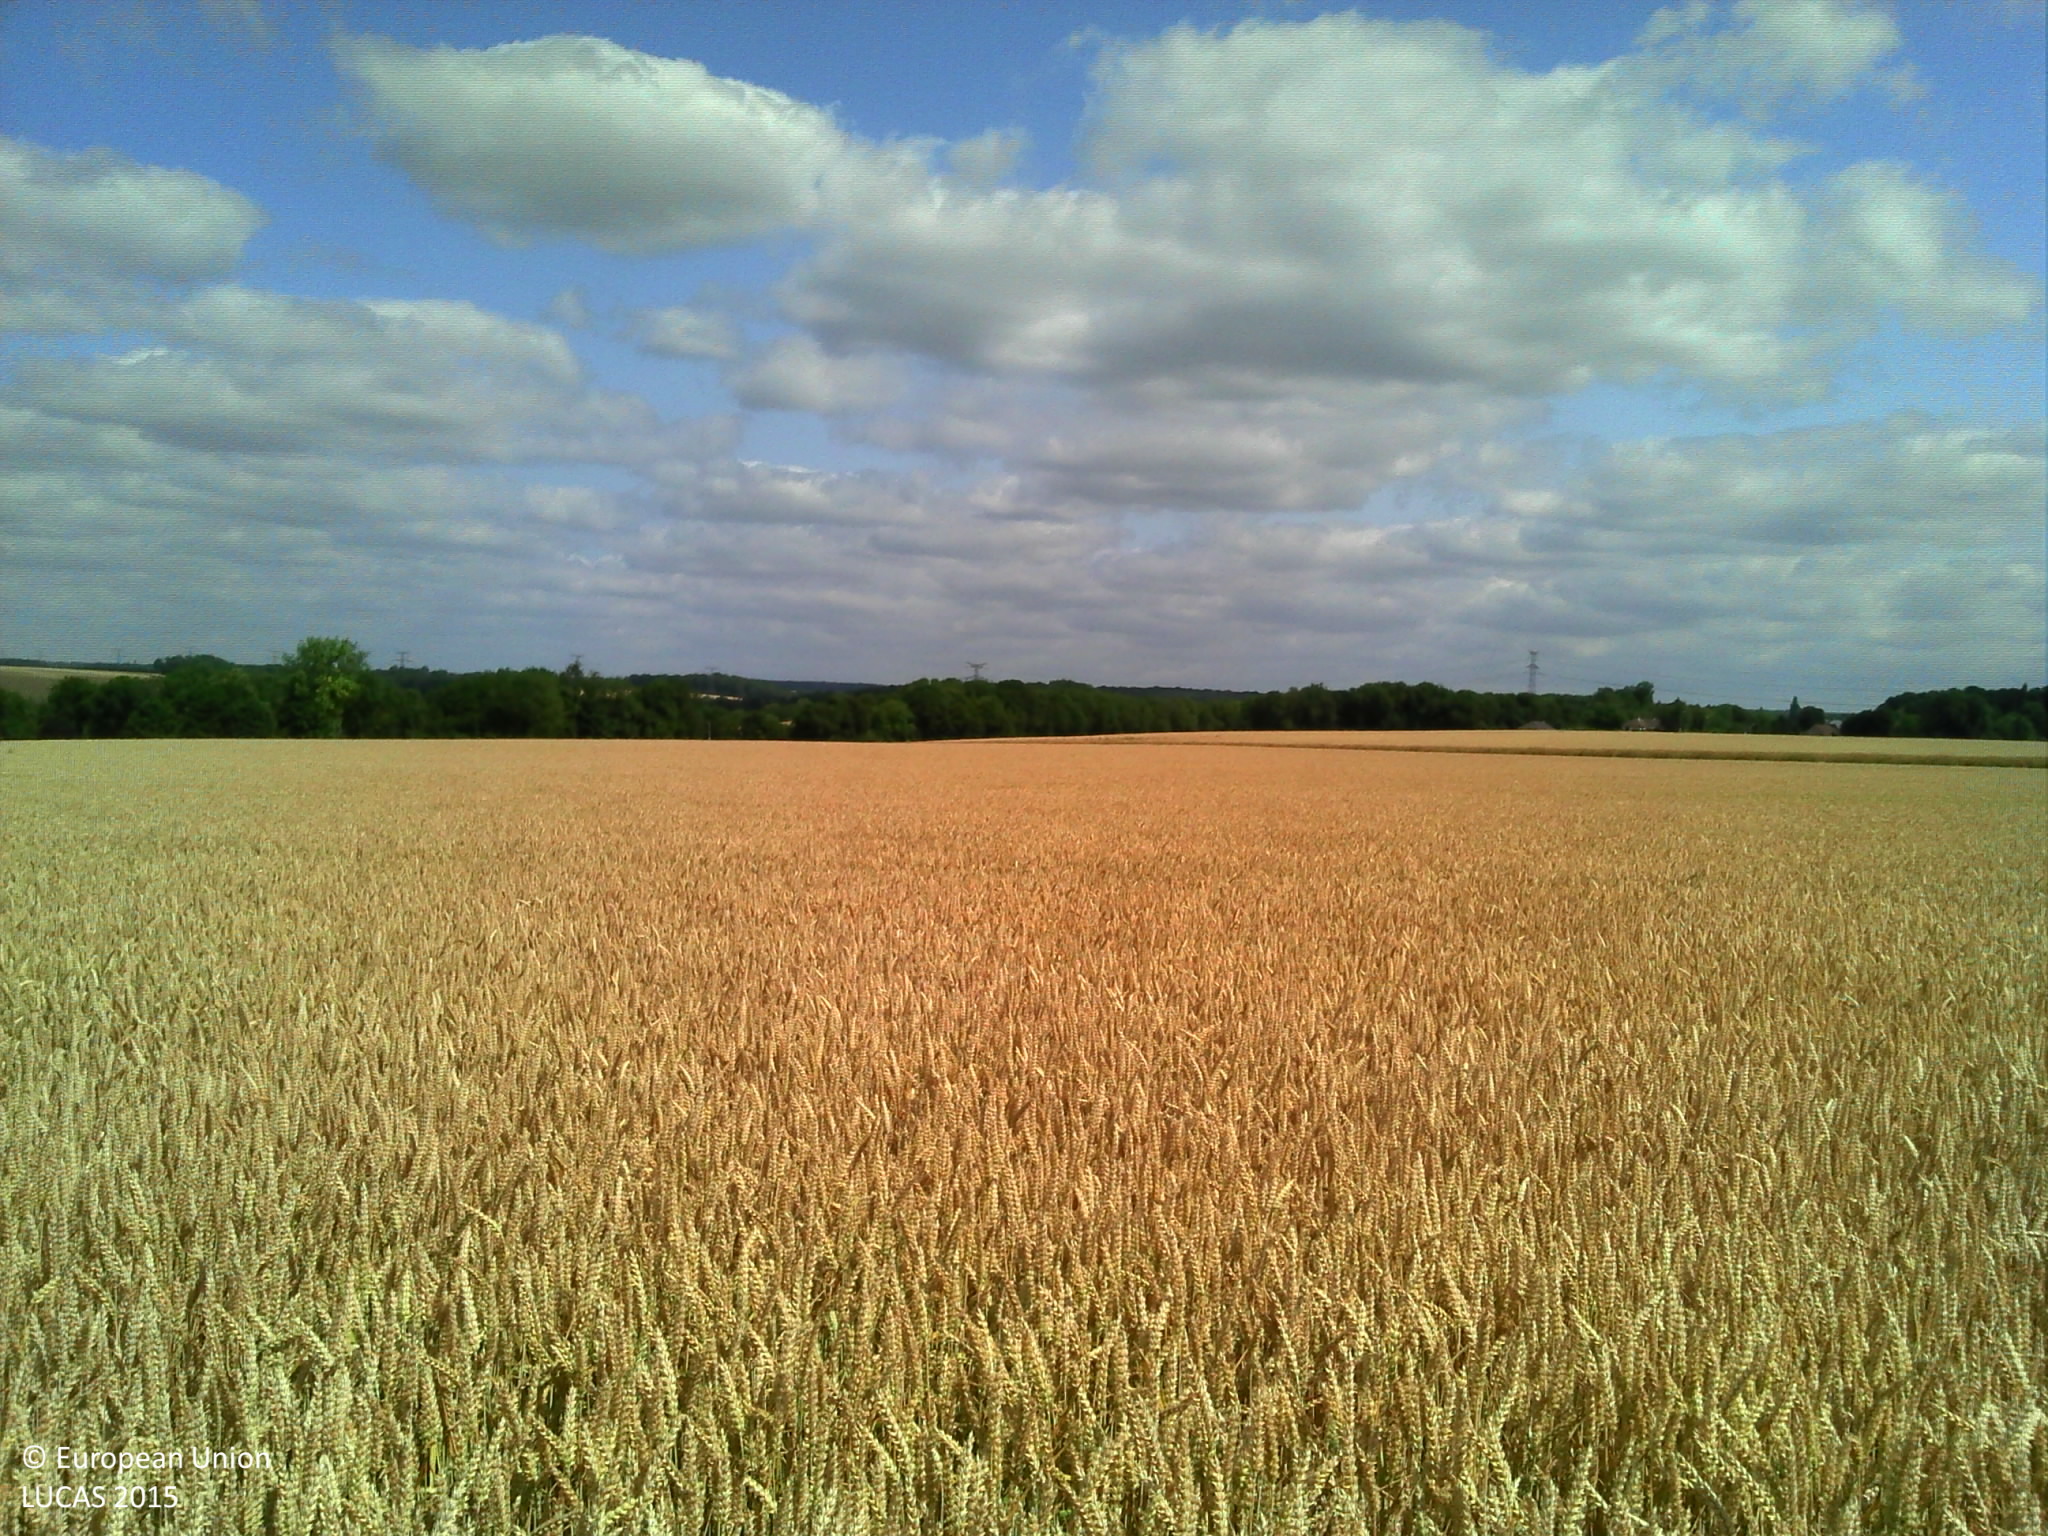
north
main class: Cropland
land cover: Common wheat
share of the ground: > 75 %
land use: Agriculture (excluding fallow land and kitchen gardens)
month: July
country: FR
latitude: 49.3299
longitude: 1.8242
